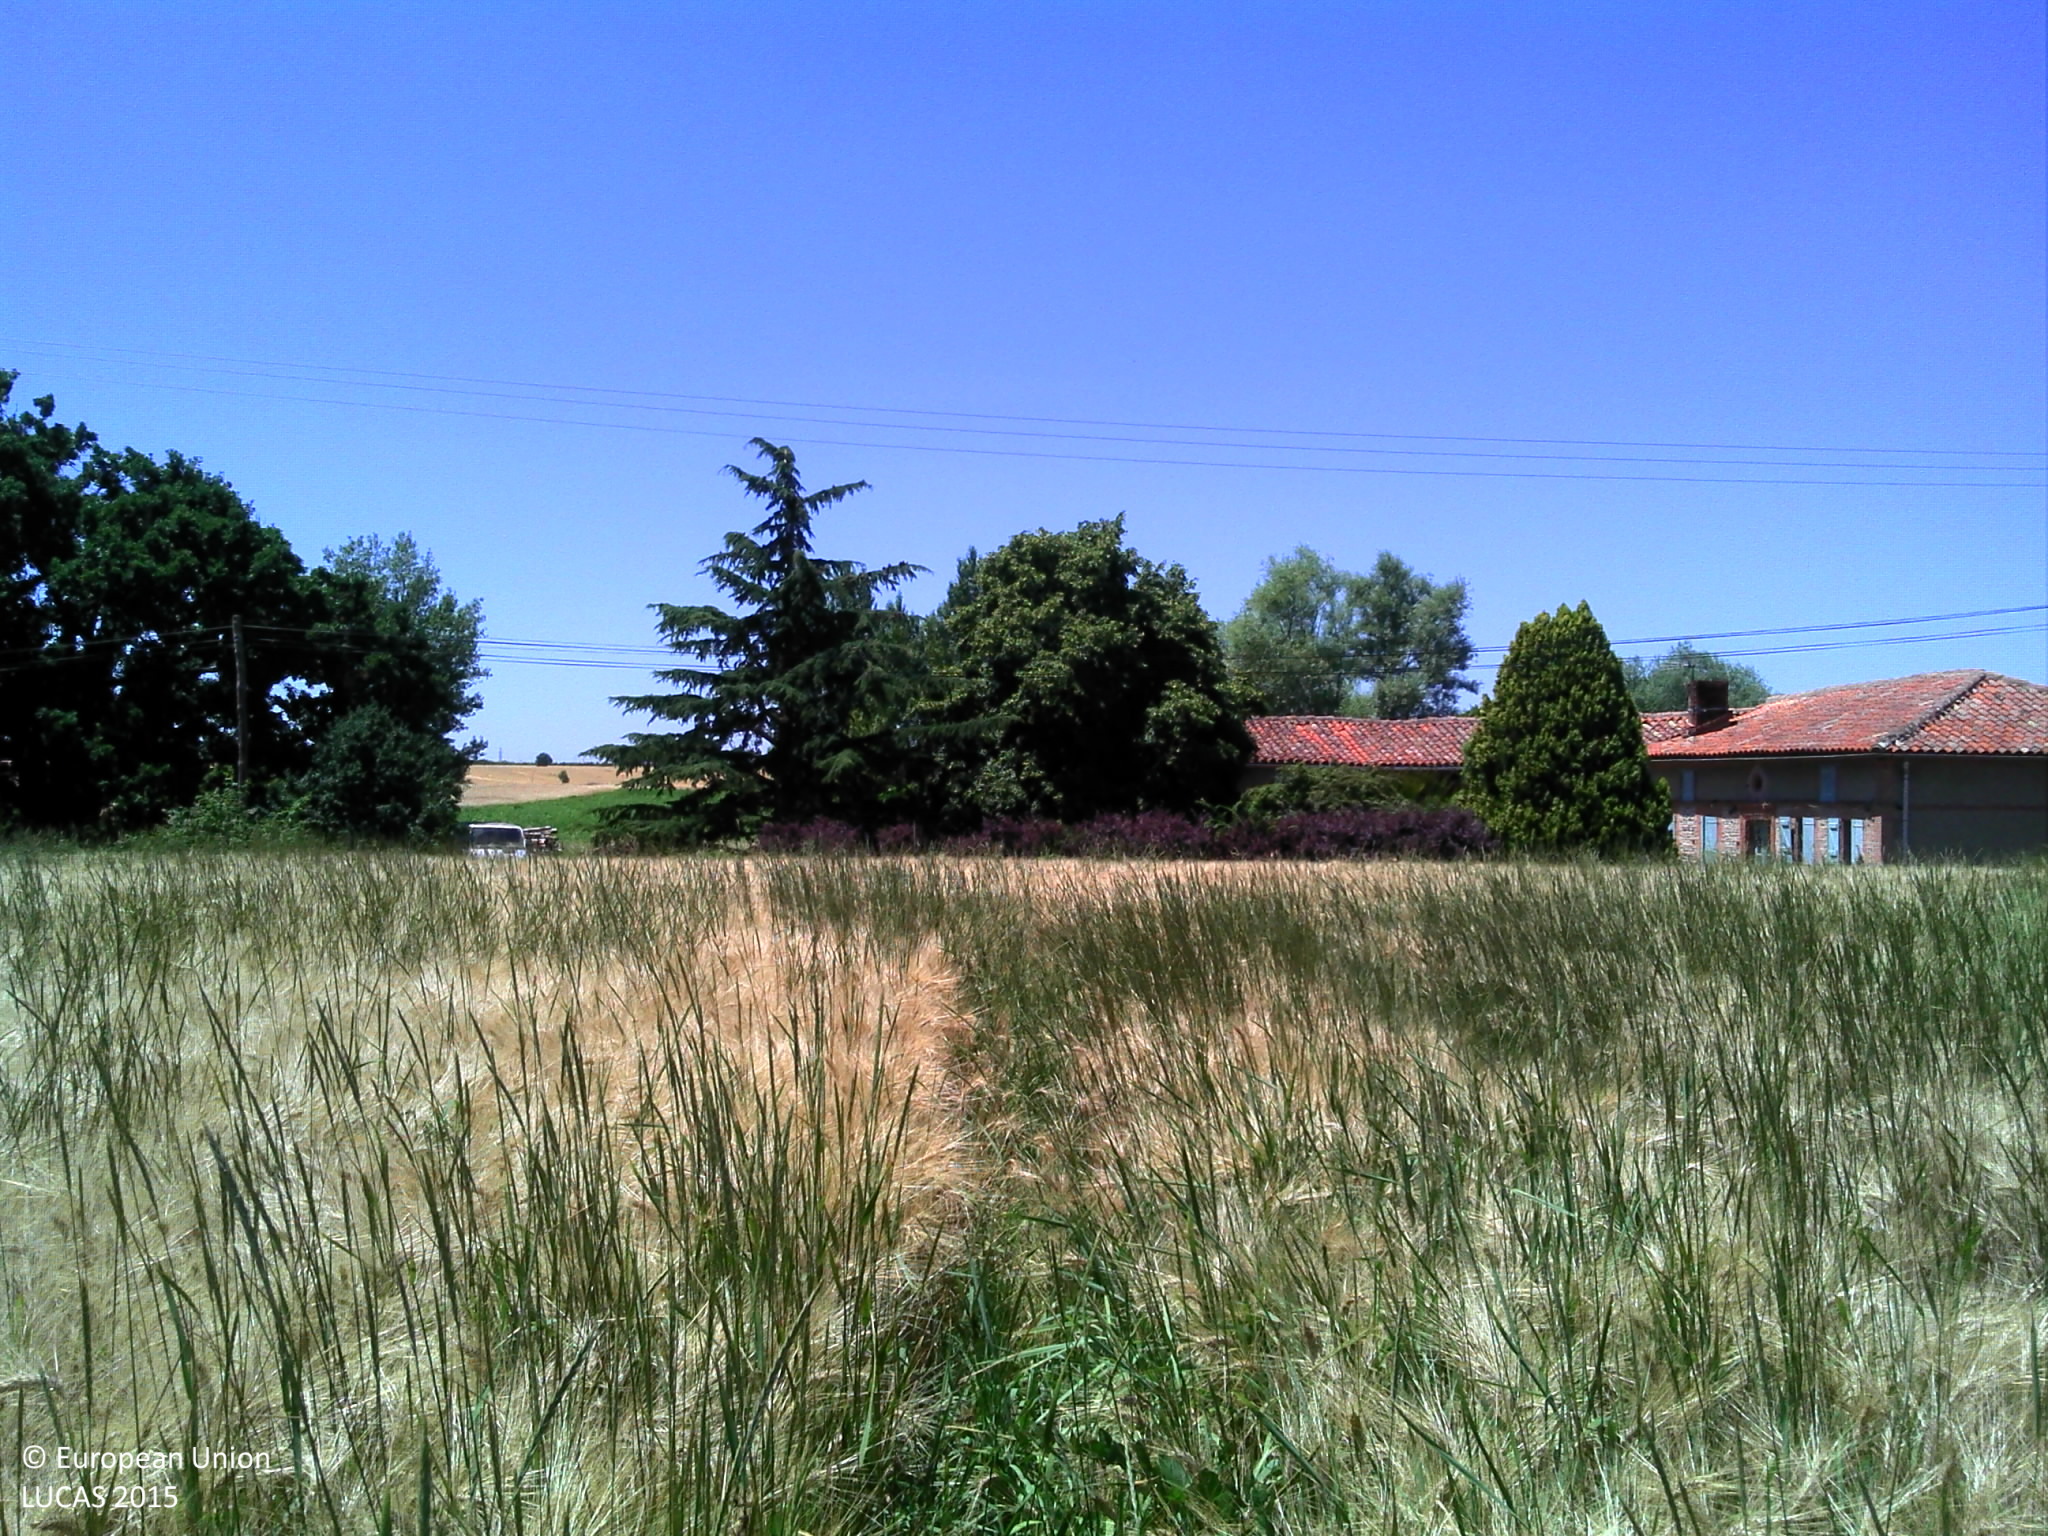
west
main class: Cropland
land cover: Barley
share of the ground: > 75 %
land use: Agriculture (excluding fallow land and kitchen gardens)
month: June
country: FR
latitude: 43.7127
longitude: 1.3011
